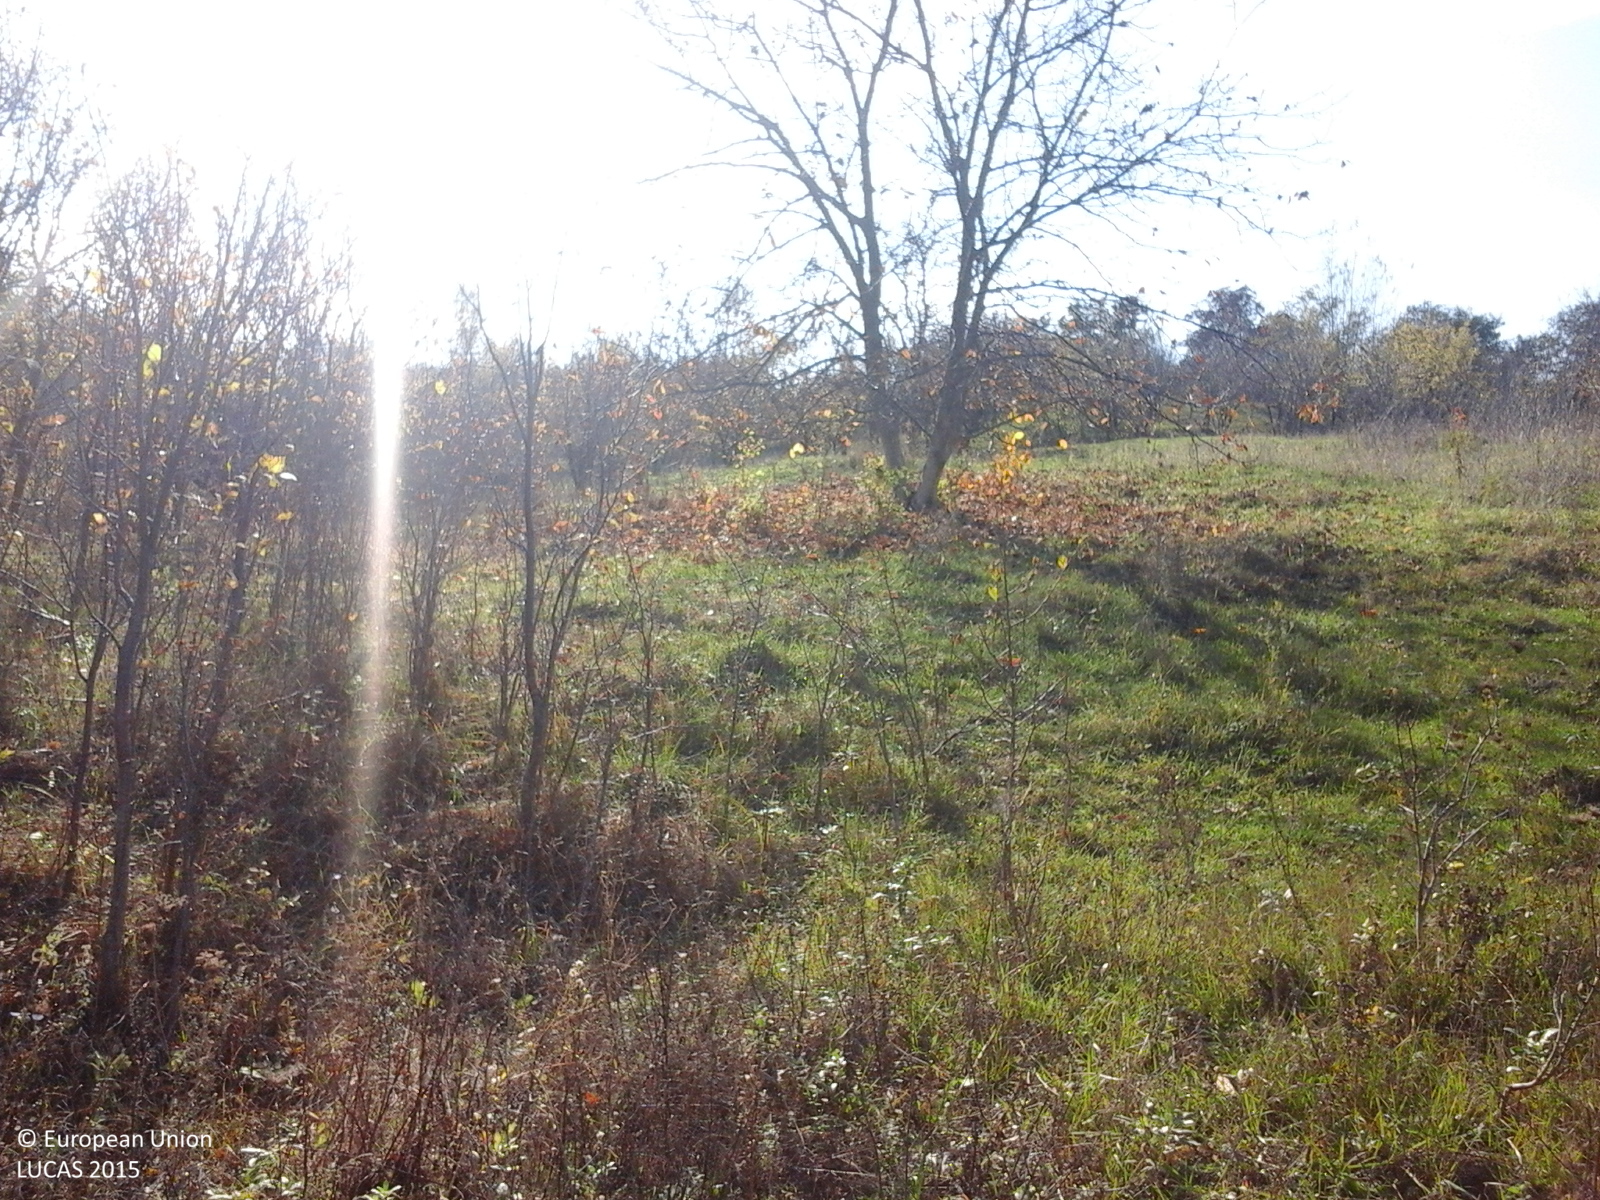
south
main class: Grassland
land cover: Grassland with sparse tree/shrub cover
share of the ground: > 75 %
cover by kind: herbaceous plants 85 %, shrubs 10 %, broadleaved forest trees 5 %
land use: Agriculture (excluding fallow land and kitchen gardens)
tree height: > 5 m
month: October
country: RO
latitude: 45.6070
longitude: 26.9746
